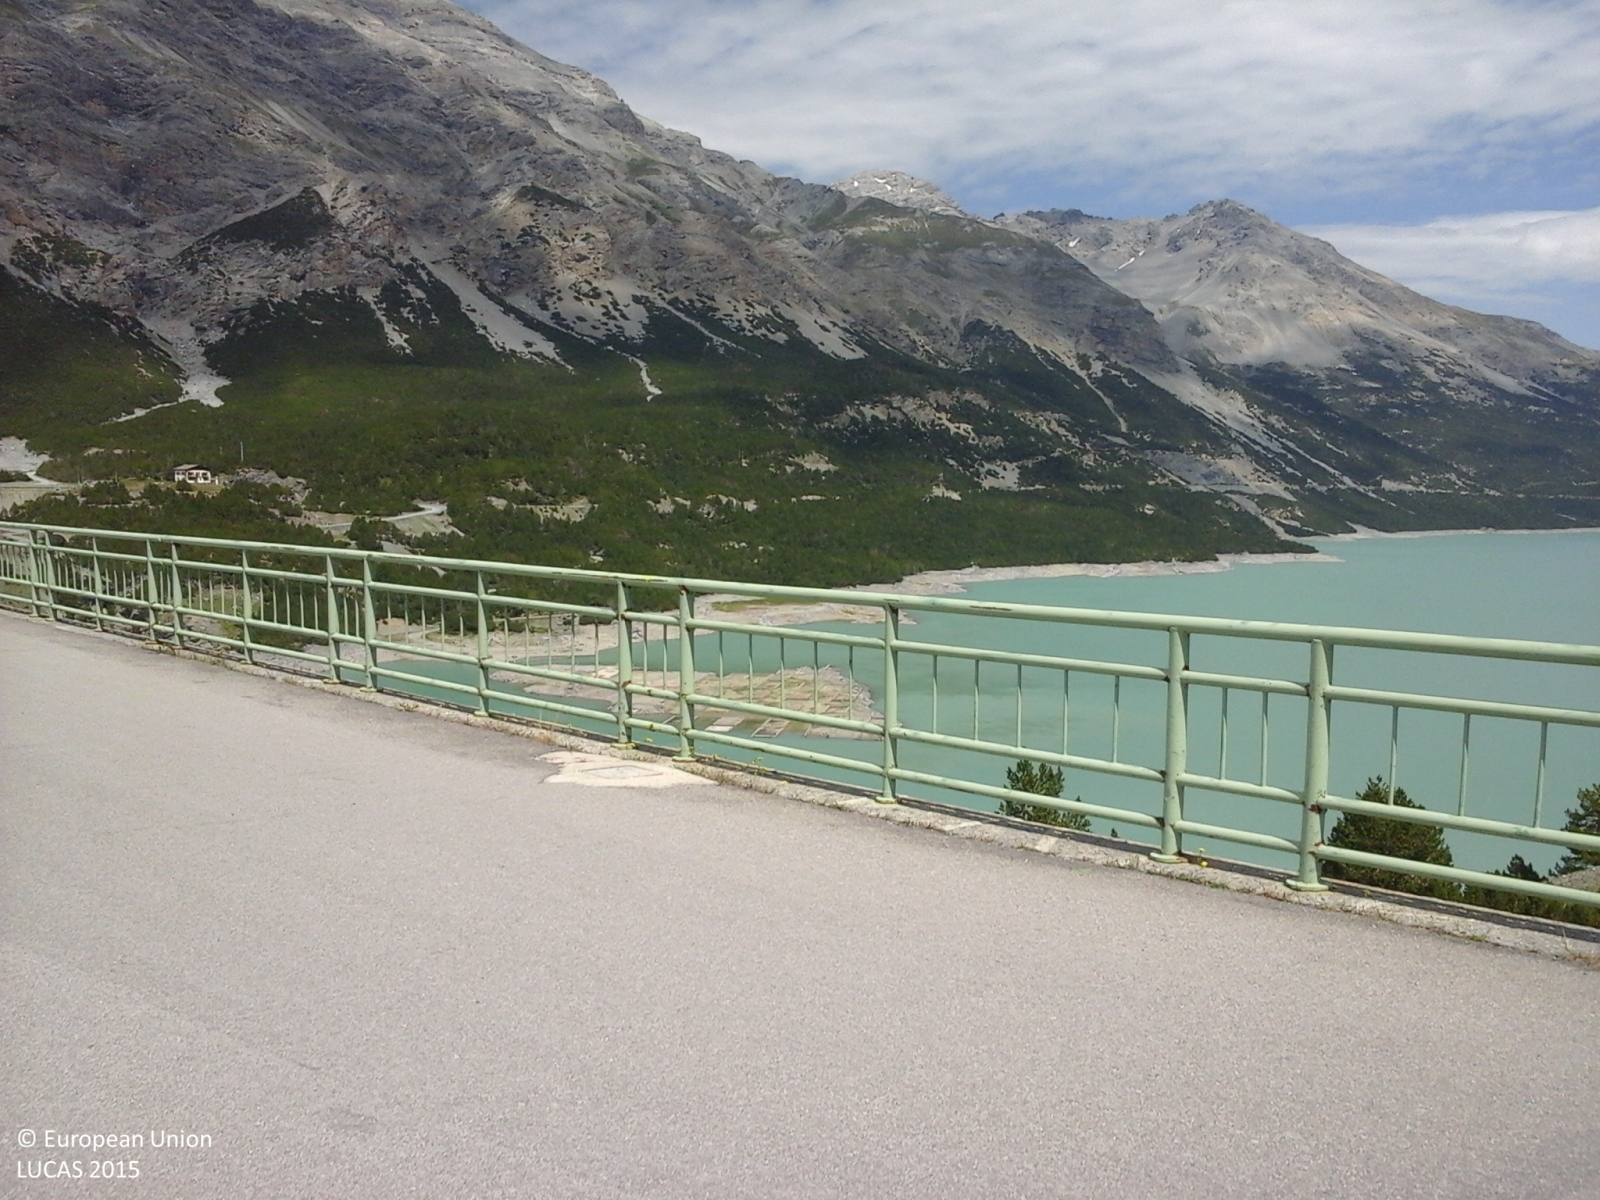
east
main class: Woodland
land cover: Spruce dominated coniferous woodland
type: alpine coniferous forest
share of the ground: > 75 %
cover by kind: coniferous forest trees 100 %
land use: Semi-natural and natural areas not in use
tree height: > 5 m
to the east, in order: Spruce dominated coniferous woodland
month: July
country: IT
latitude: 46.5310
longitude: 10.2734
